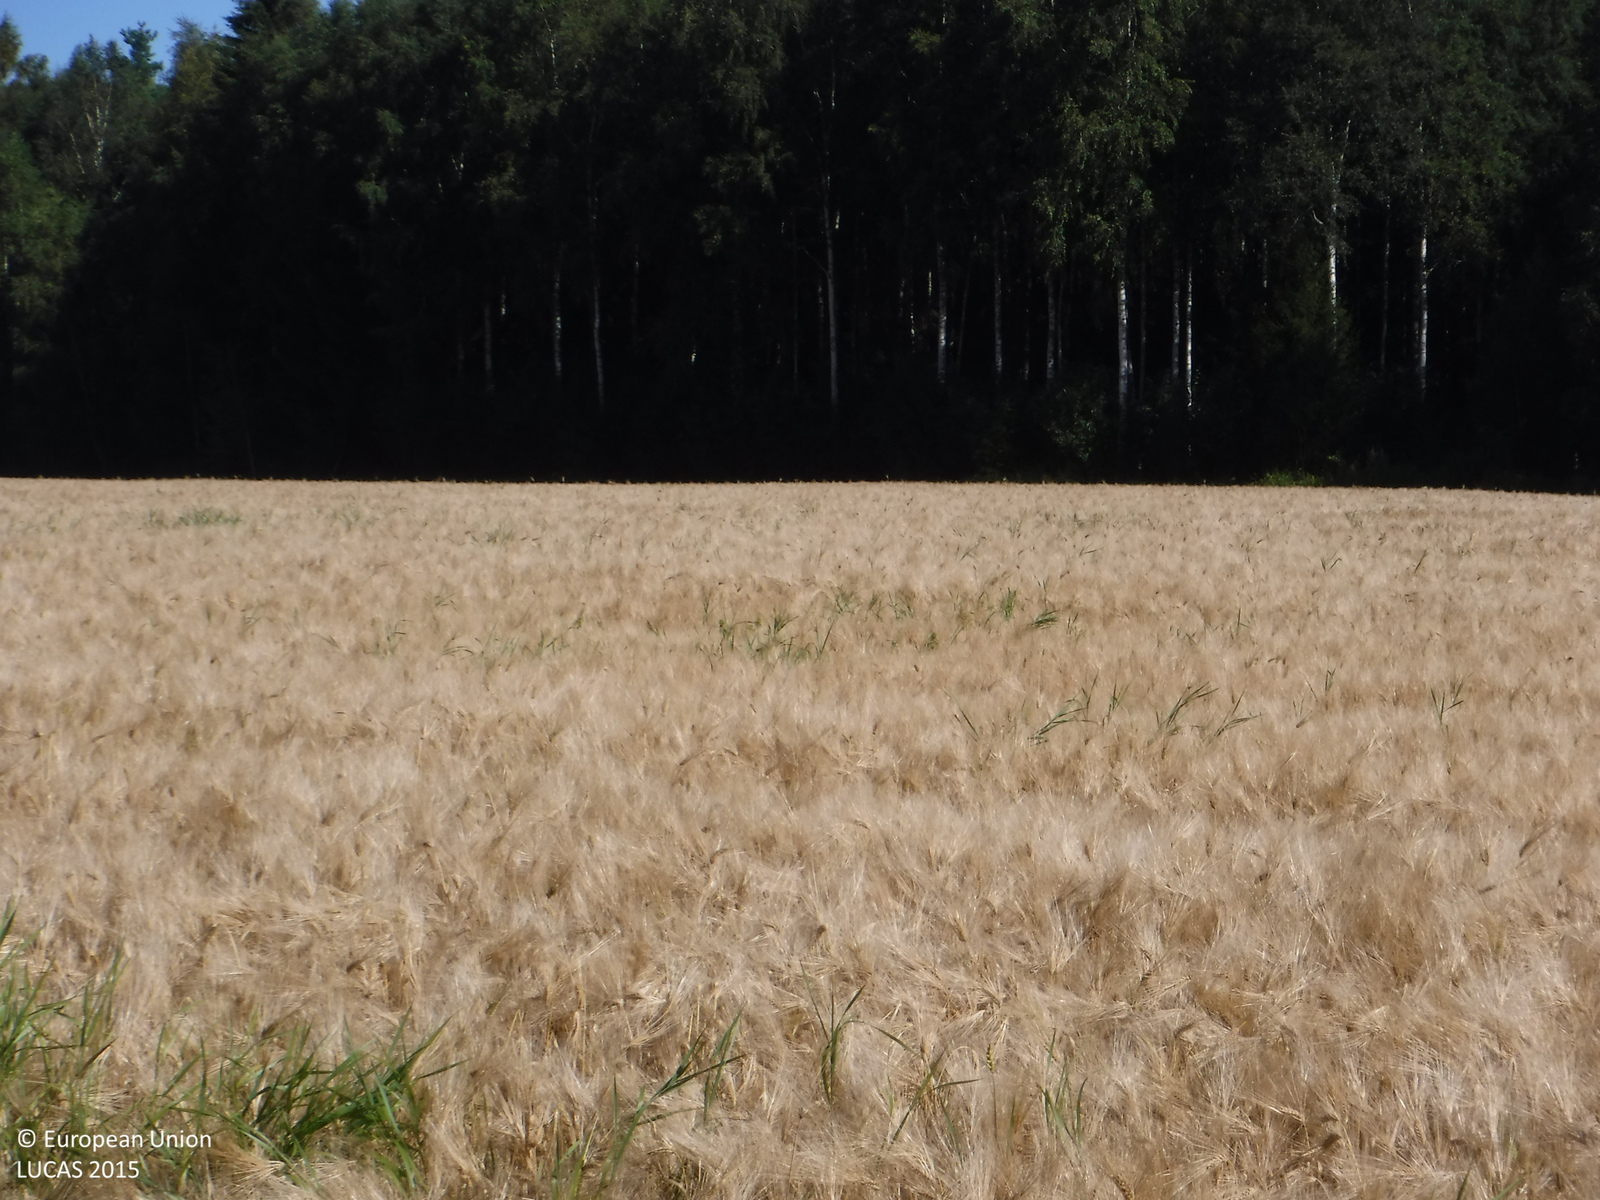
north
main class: Cropland
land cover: Barley
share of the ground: > 75 %
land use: Agriculture (excluding fallow land and kitchen gardens)
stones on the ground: < 10 %
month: August
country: FI
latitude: 61.1297
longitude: 21.7340
